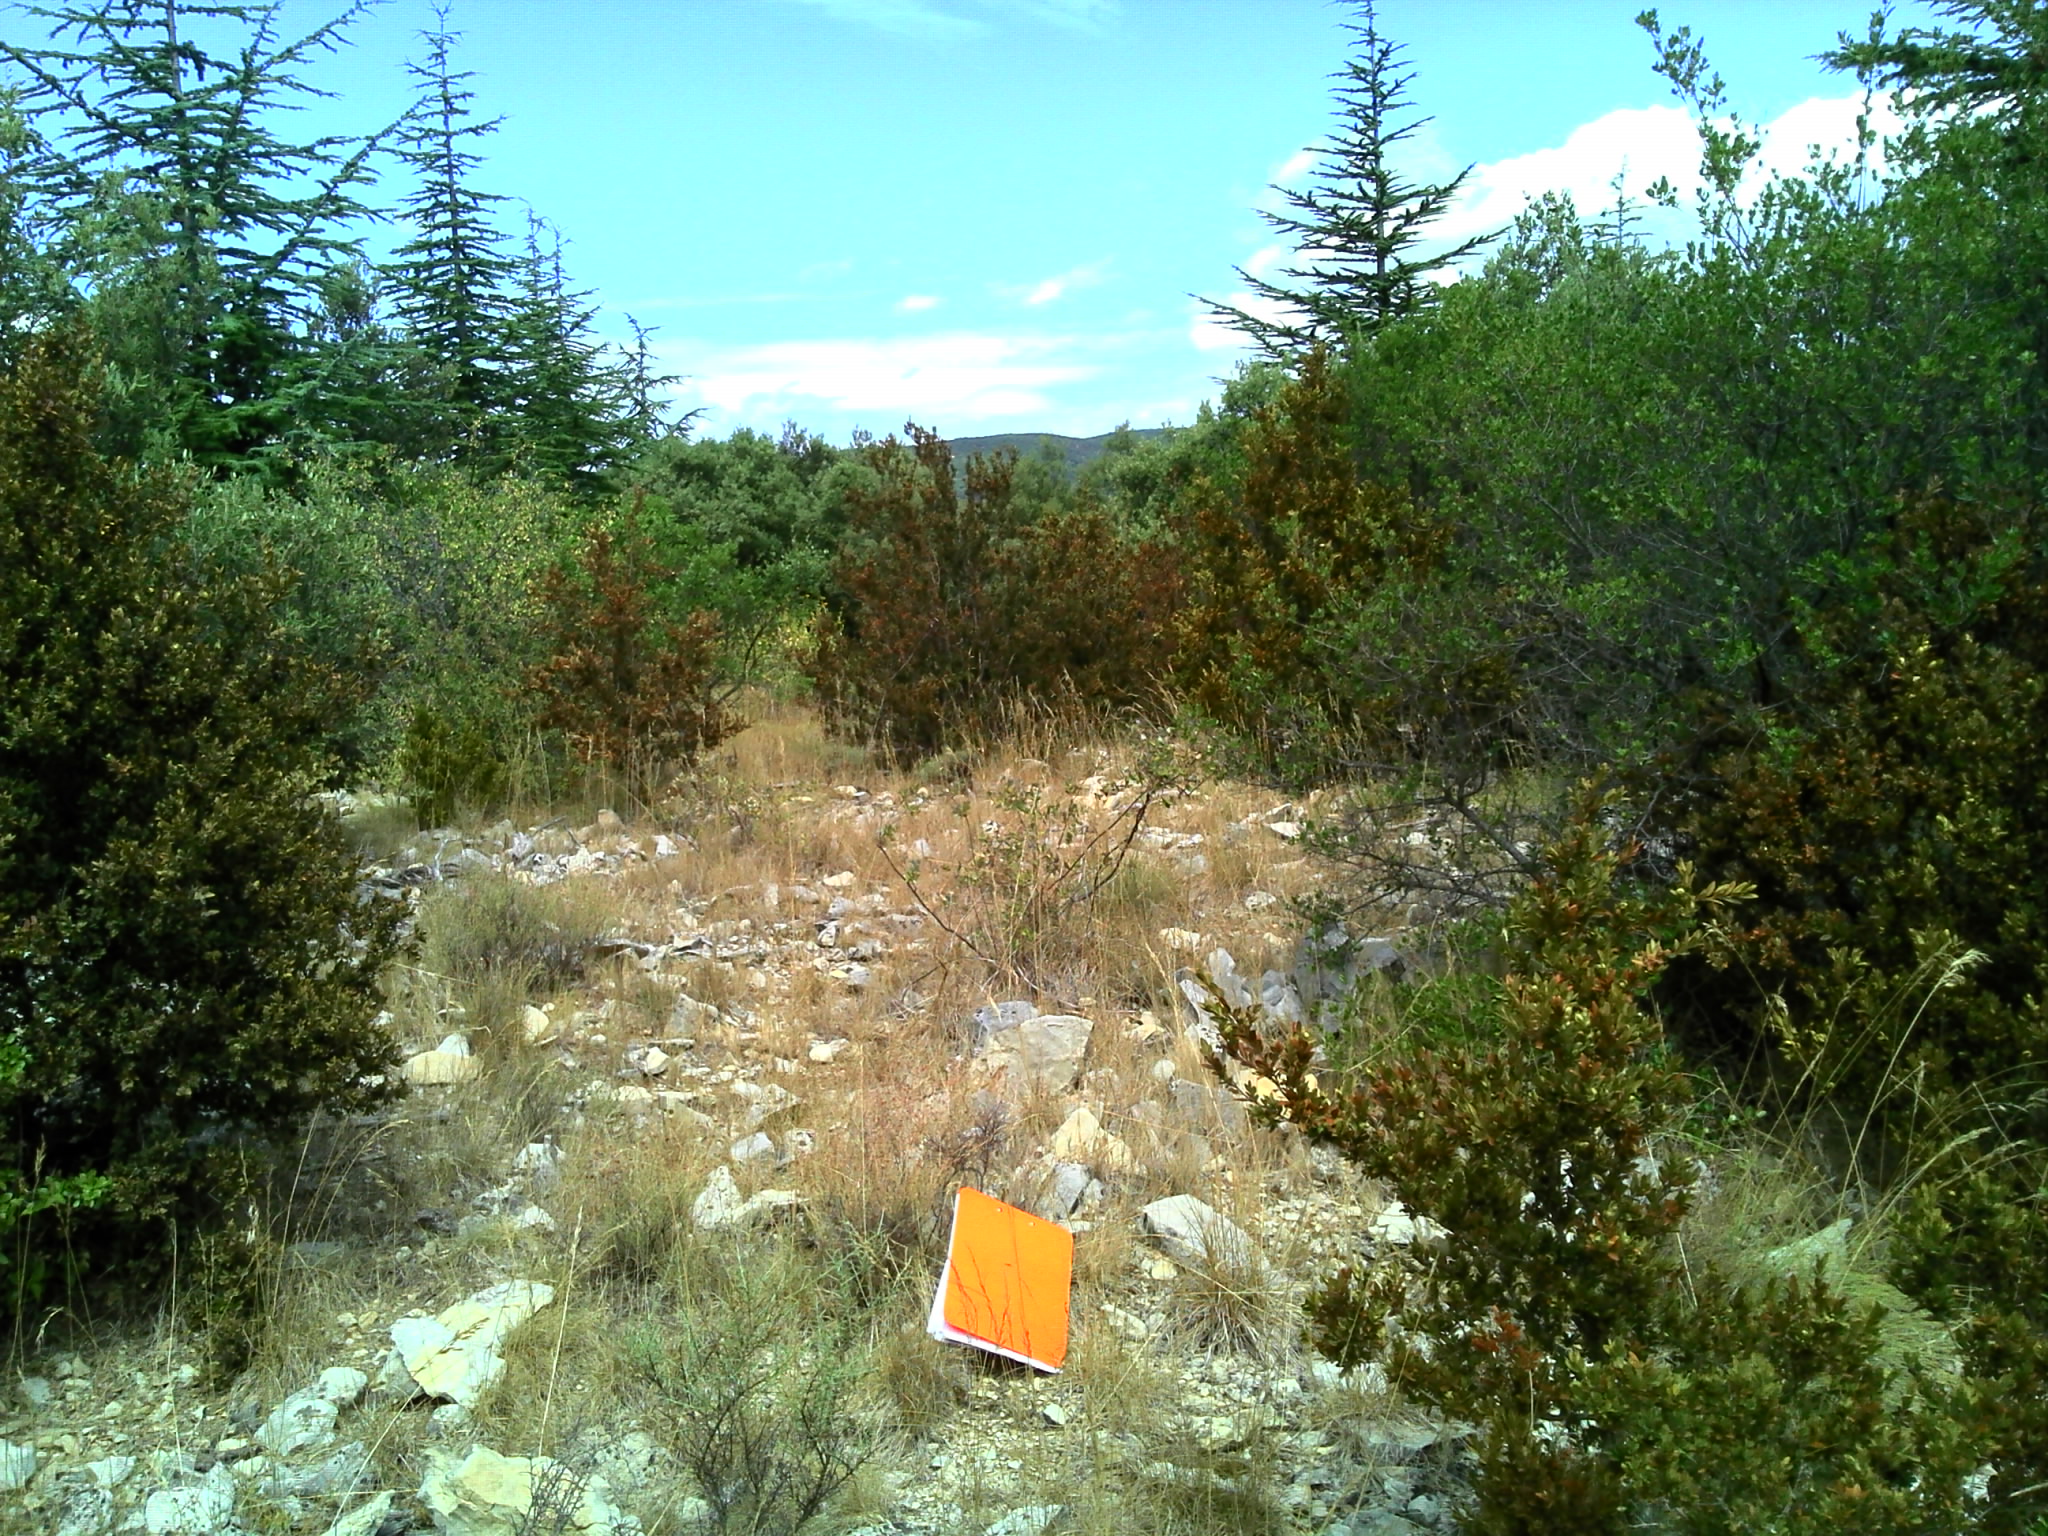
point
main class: Woodland
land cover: Other mixed woodland
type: broadleaved evergreen forest
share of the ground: 50 - 75 %
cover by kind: coniferous forest trees 35 %, broadleaved forest trees 35 %, herbaceous plants 15 %, unconsolidated bare surface 15 %
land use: Semi-natural and natural areas not in use
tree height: > 5 m
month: July
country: FR
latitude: 44.1034
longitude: 4.2987
